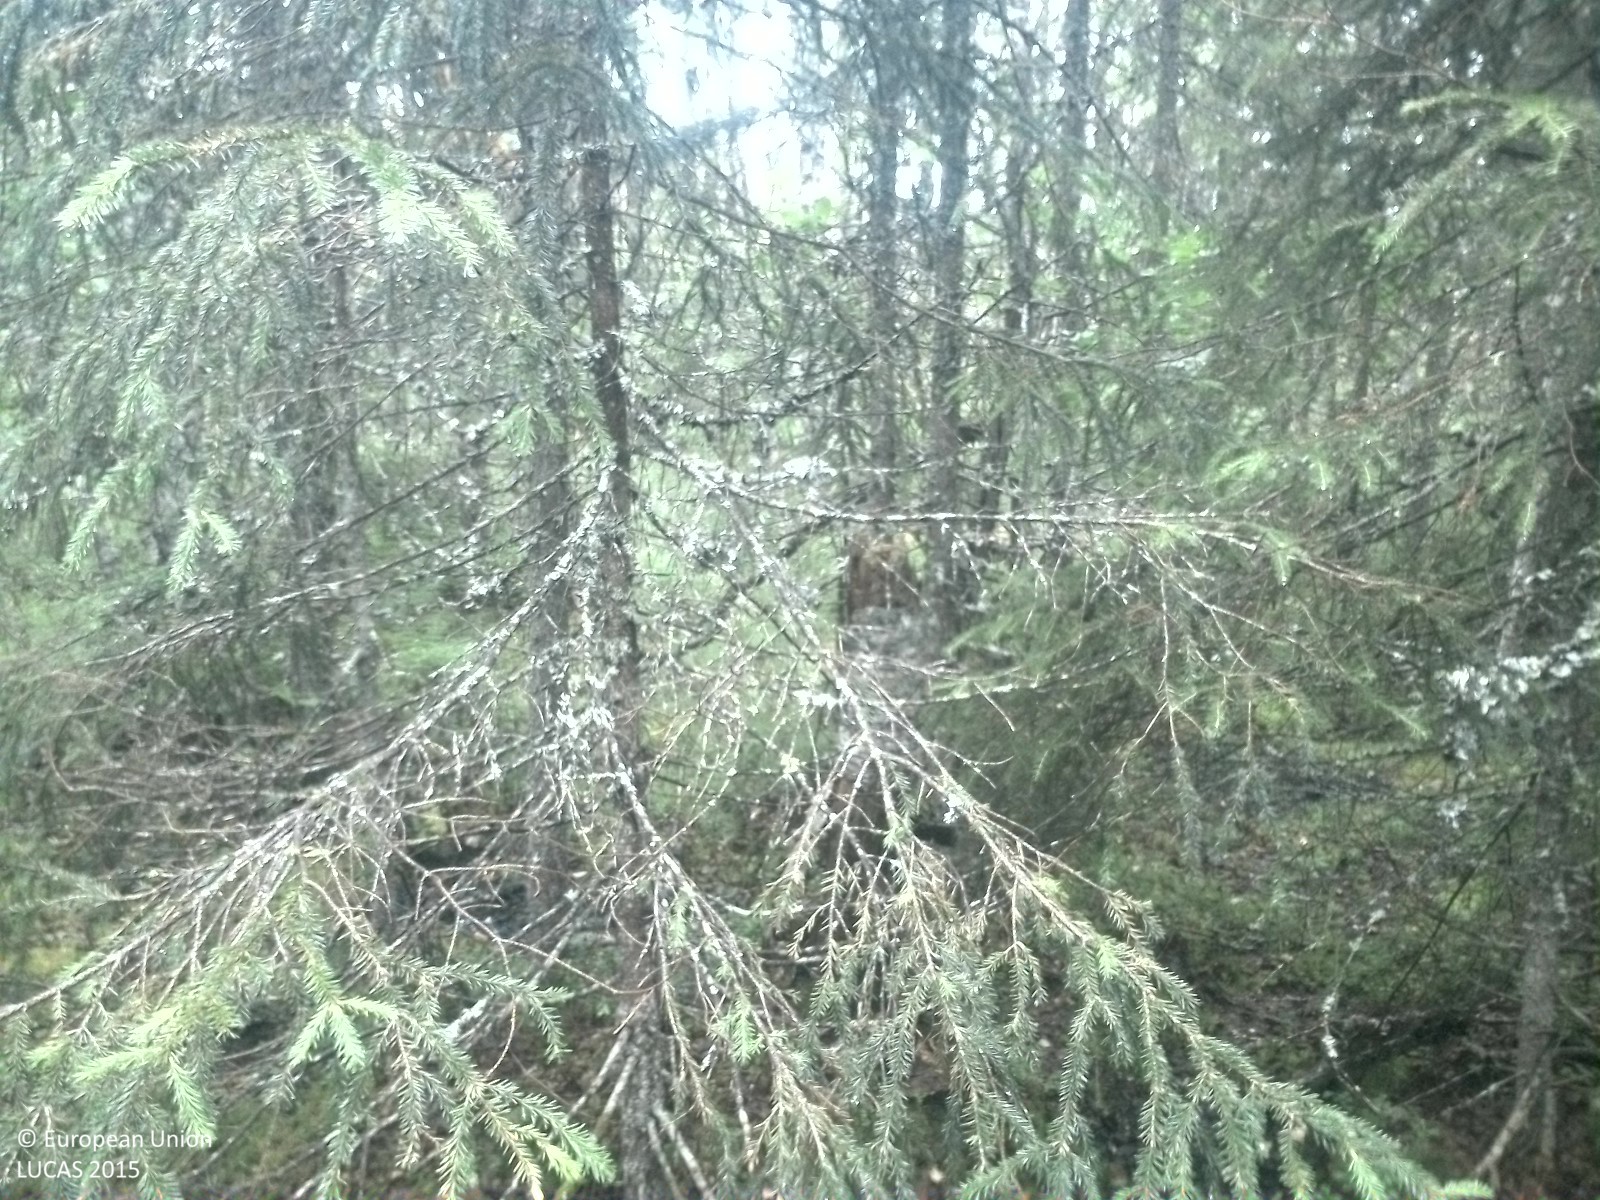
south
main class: Woodland
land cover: Spruce dominated mixed woodland
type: boreal forest
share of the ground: > 75 %
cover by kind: broadleaved forest trees 50 %, coniferous forest trees 35 %, shrubs 15 %
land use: Semi-natural and natural areas not in use
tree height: > 5 m
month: August
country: SE
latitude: 62.3002
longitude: 16.2859
